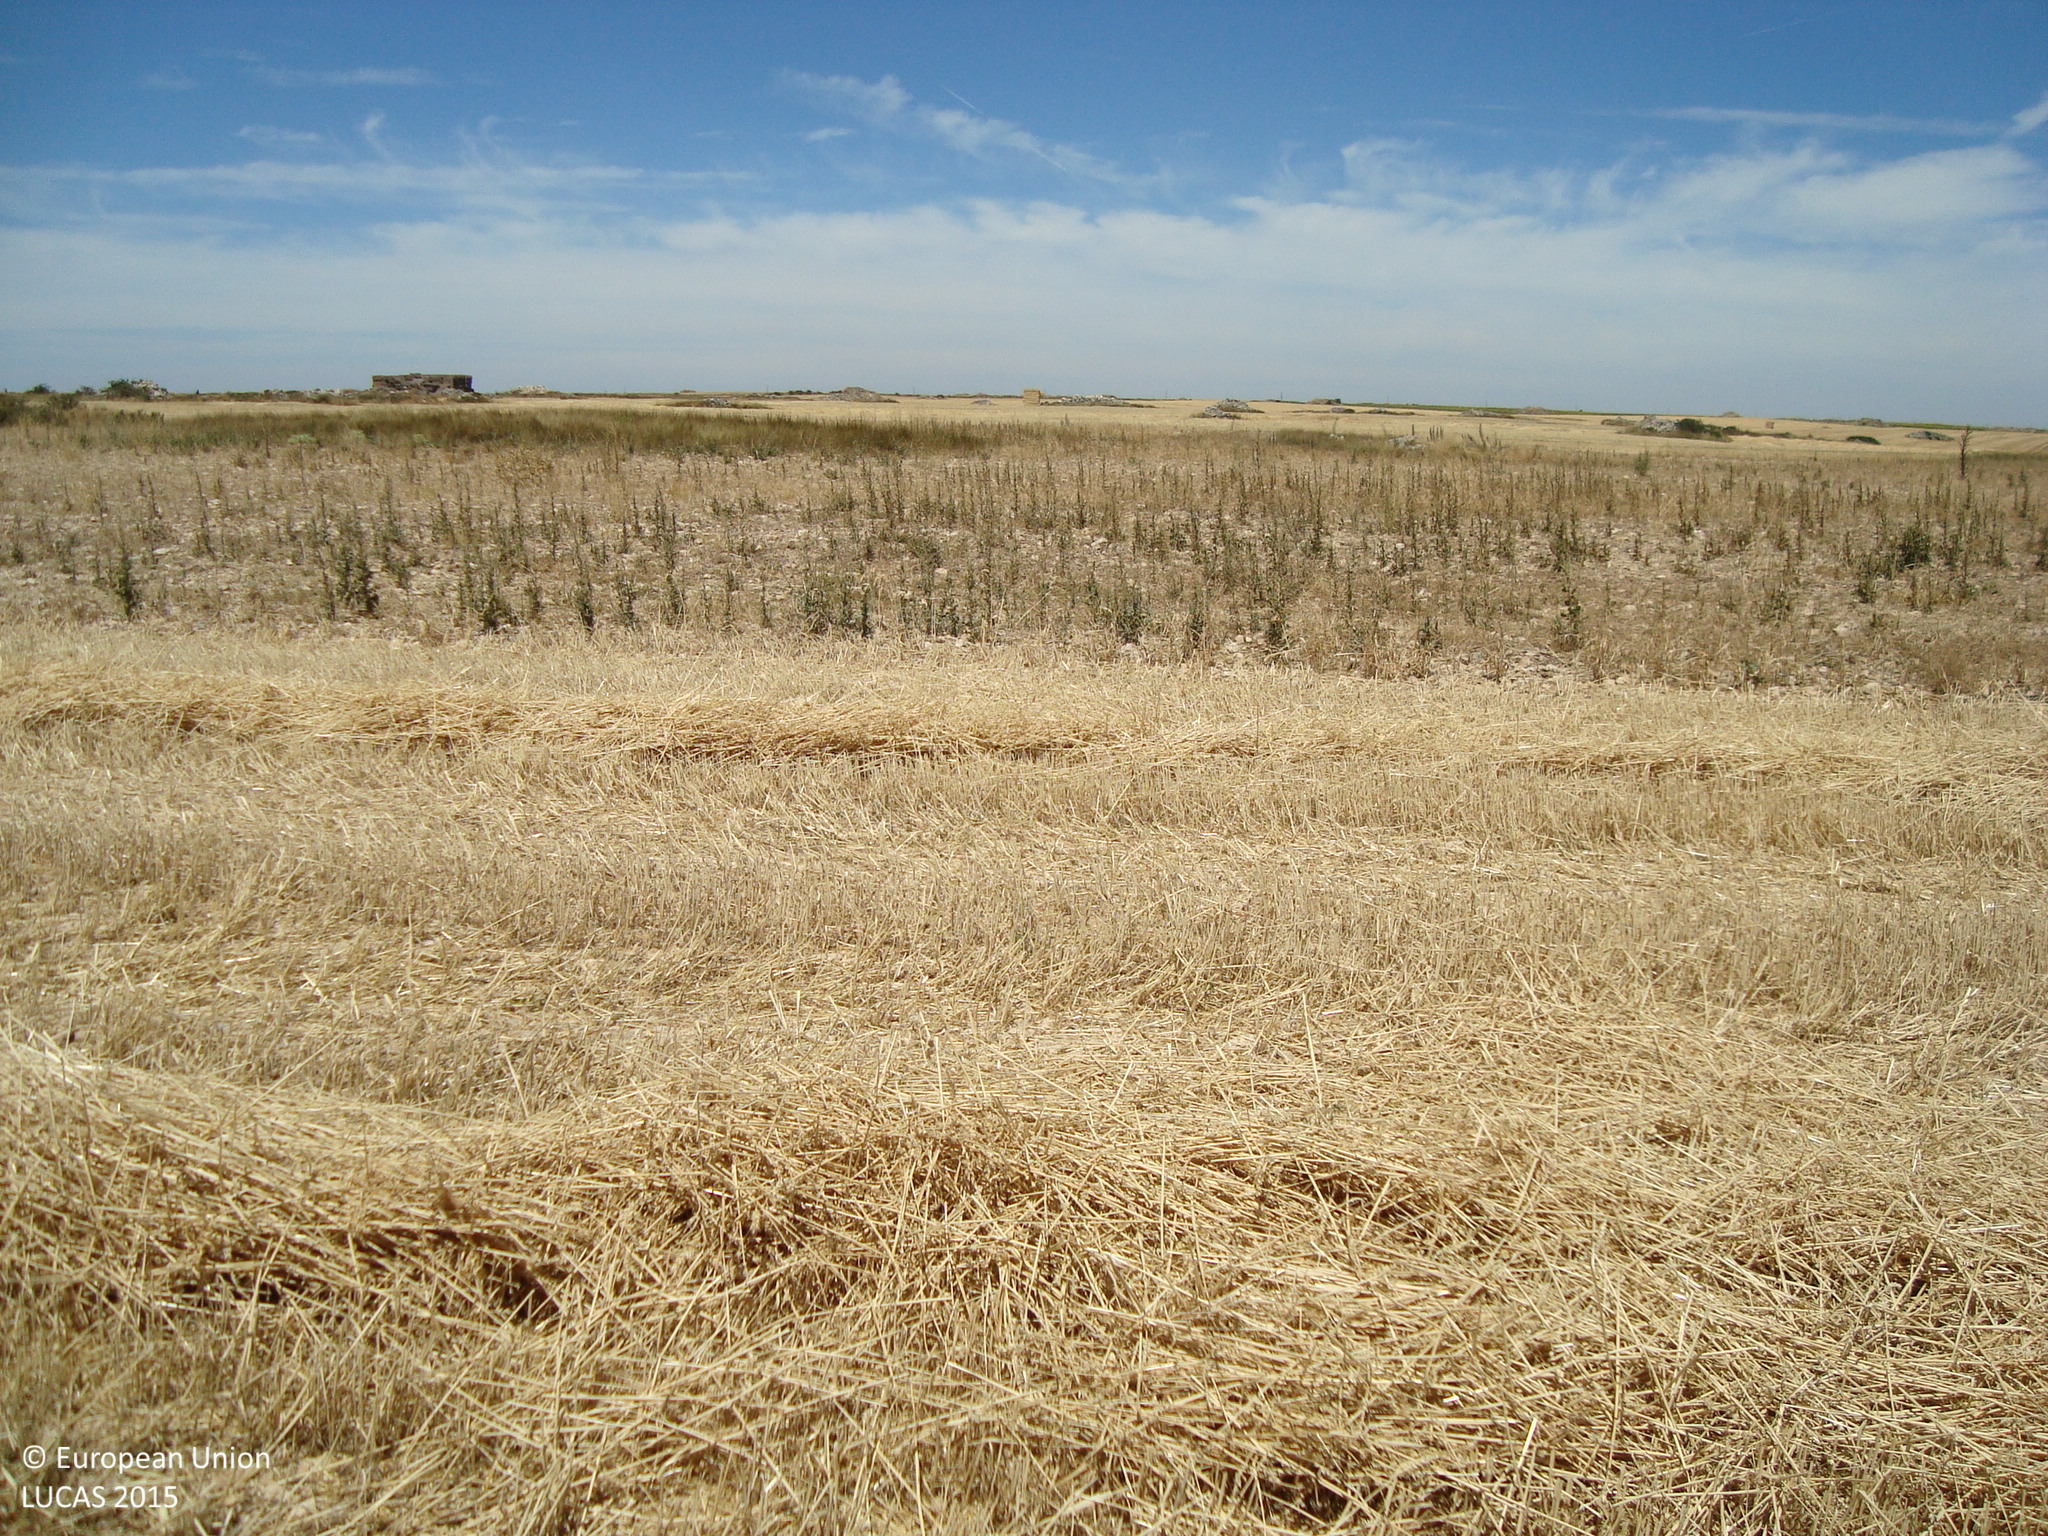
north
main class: Cropland
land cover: Common wheat
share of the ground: < 10 %
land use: Agriculture (excluding fallow land and kitchen gardens)
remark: Harvested field
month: July
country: ES
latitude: 42.2662
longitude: -3.9695
